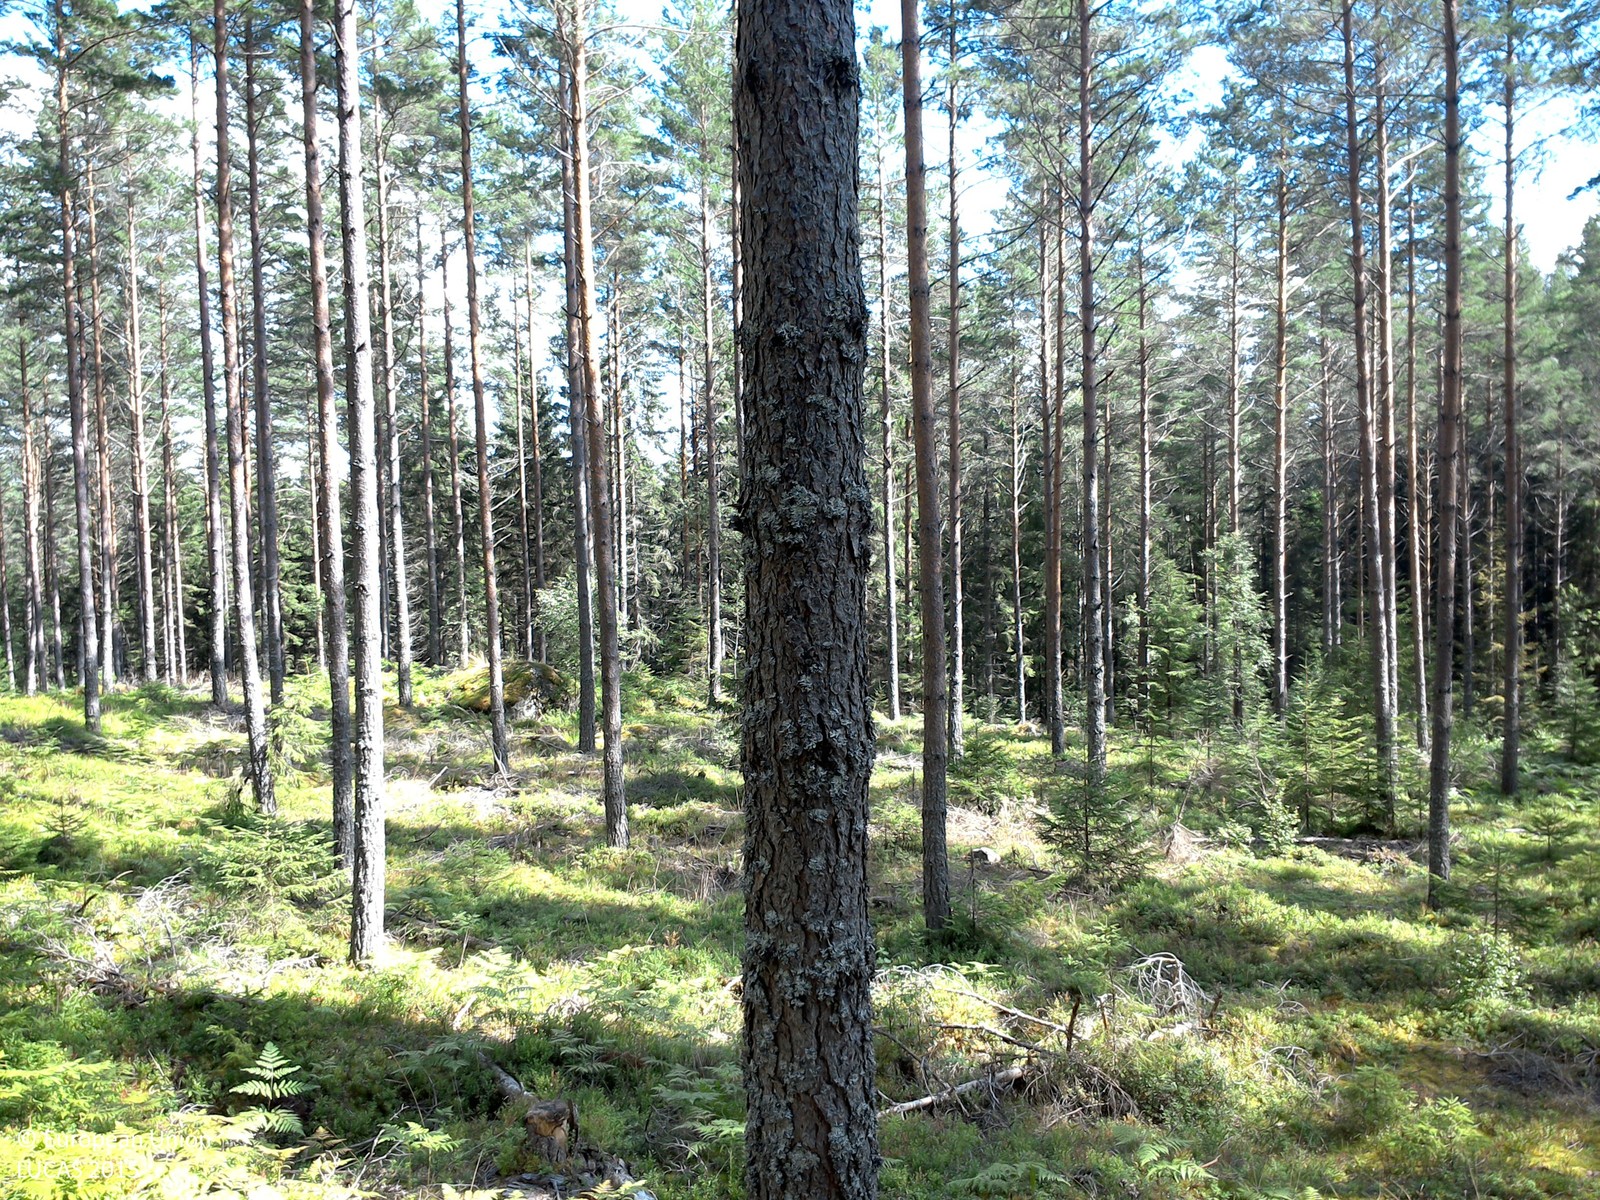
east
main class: Woodland
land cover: Pine dominated coniferous woodland
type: boreal forest
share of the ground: 25 - 50 %
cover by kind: herbaceous plants 65 %, coniferous forest trees 25 %, lichens and mosses 10 %
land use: Forestry
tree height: > 5 m
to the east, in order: Pine dominated coniferous woodland; Spruce dominated mixed woodland; Pine dominated coniferous woodland; Spruce dominated coniferous woodland
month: August
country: SE
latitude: 58.1645
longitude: 15.4171
